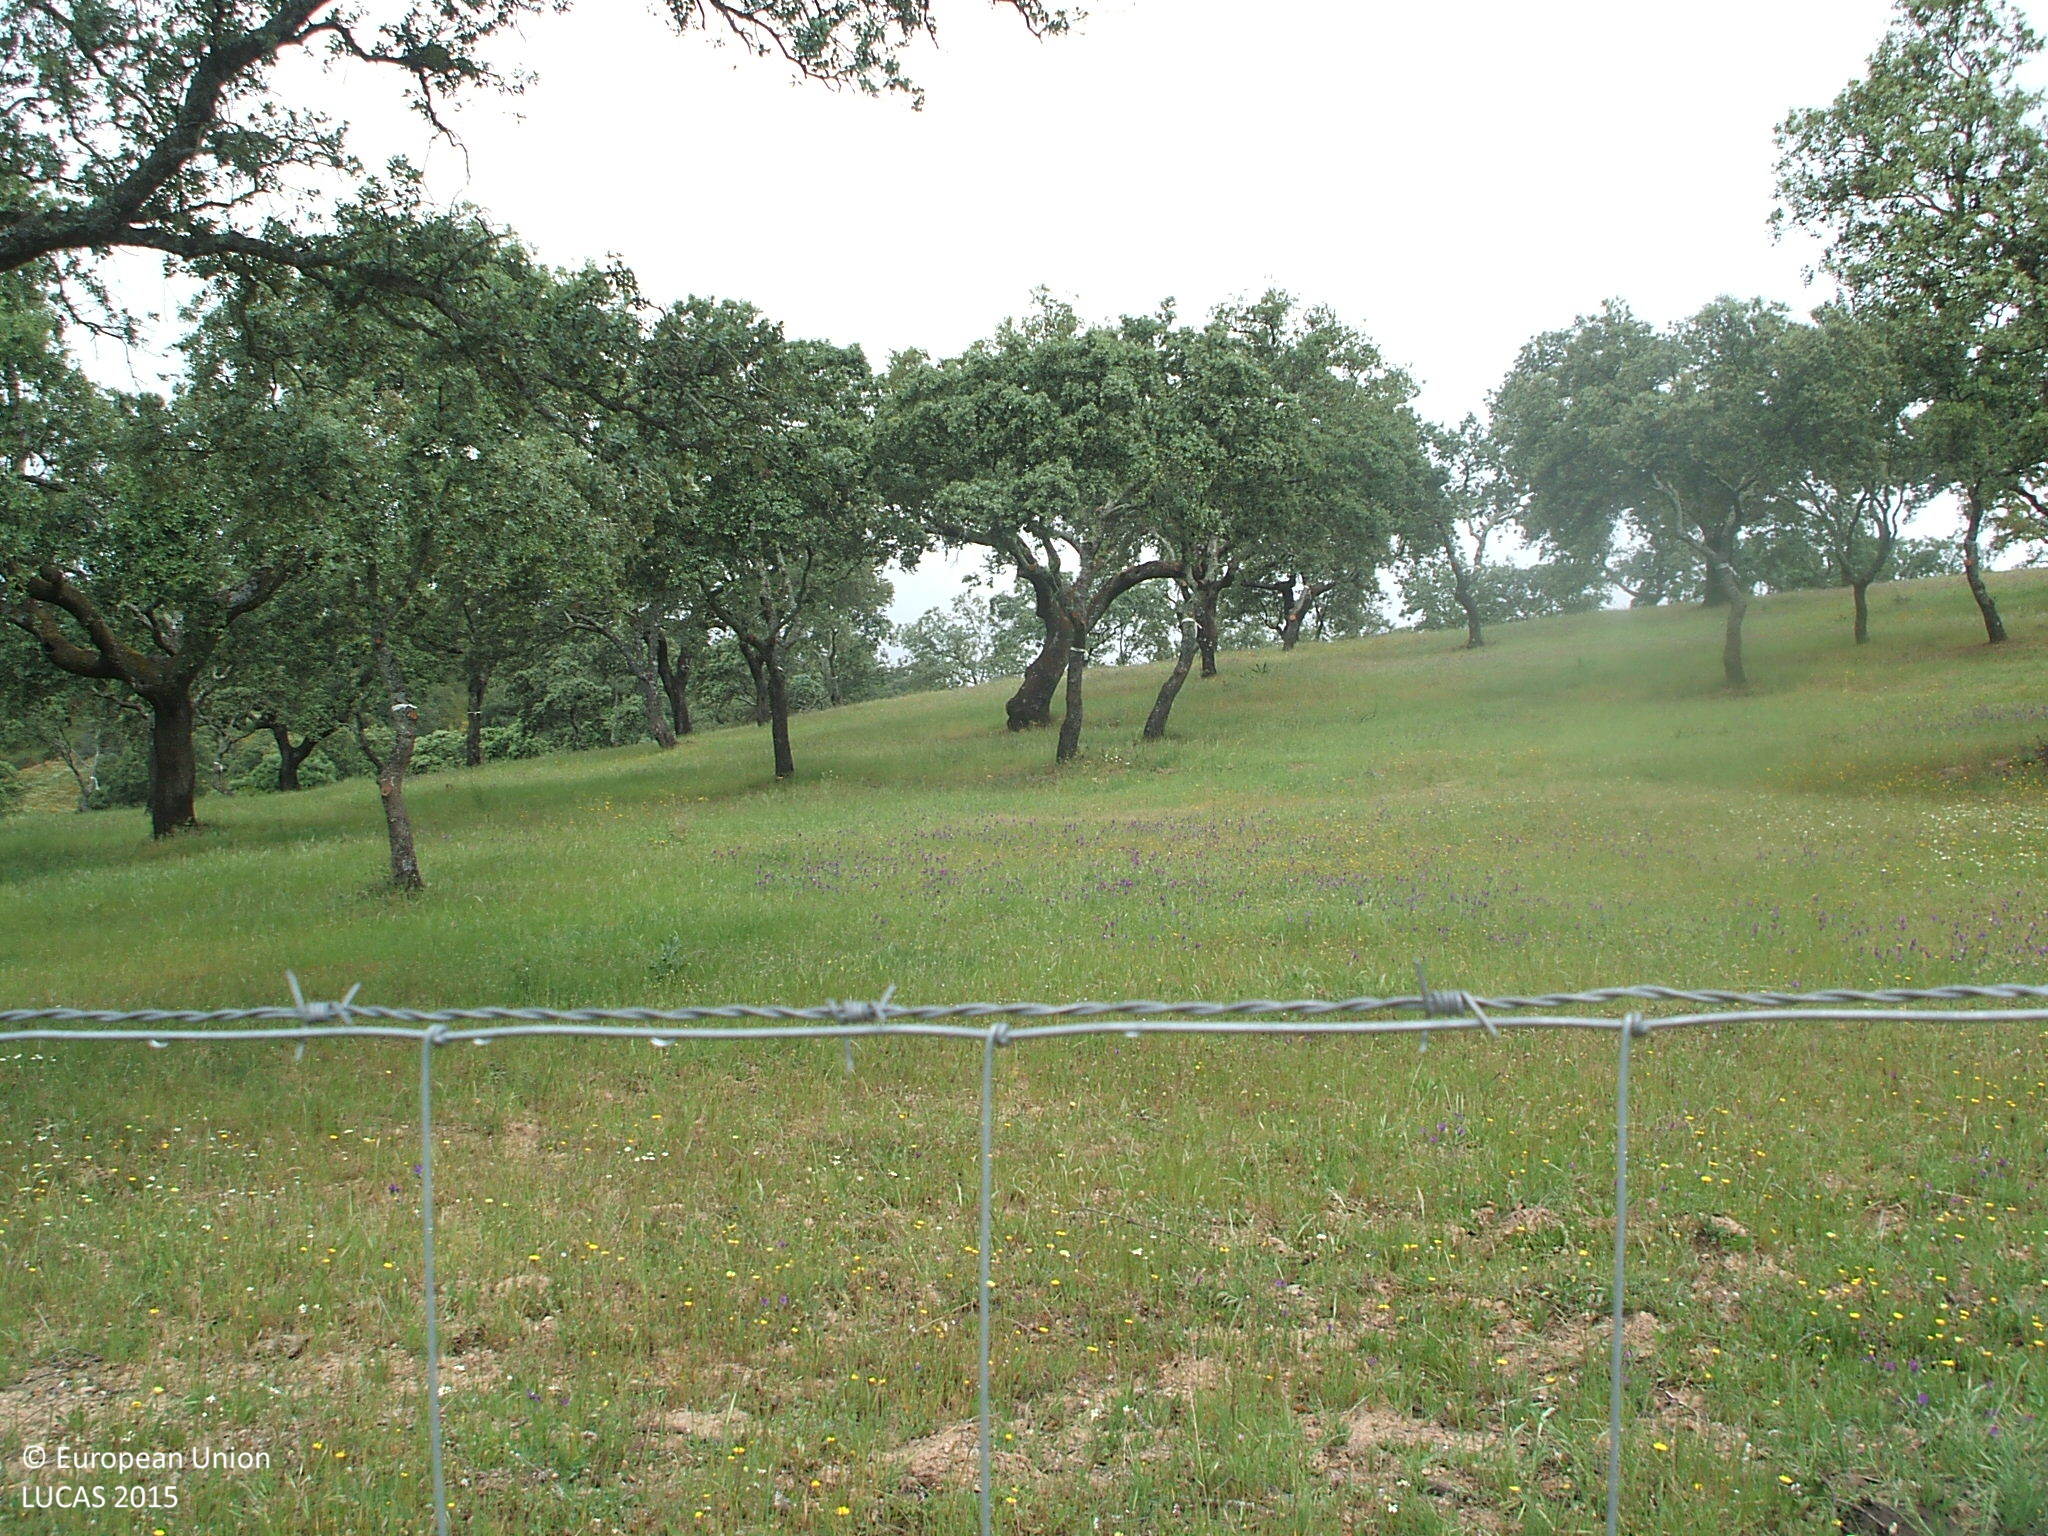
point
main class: Woodland
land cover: Broadleaved woodland
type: broadleaved evergreen forest
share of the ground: 25 - 50 %
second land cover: Grassland without tree/shrub cover
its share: > 75 %
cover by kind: herbaceous plants 60 %, broadleaved forest trees 40 %
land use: Forestry
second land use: Agriculture (excluding fallow land and kitchen gardens)
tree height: > 5 m
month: April
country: ES
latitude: 37.8326
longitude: -5.6031
